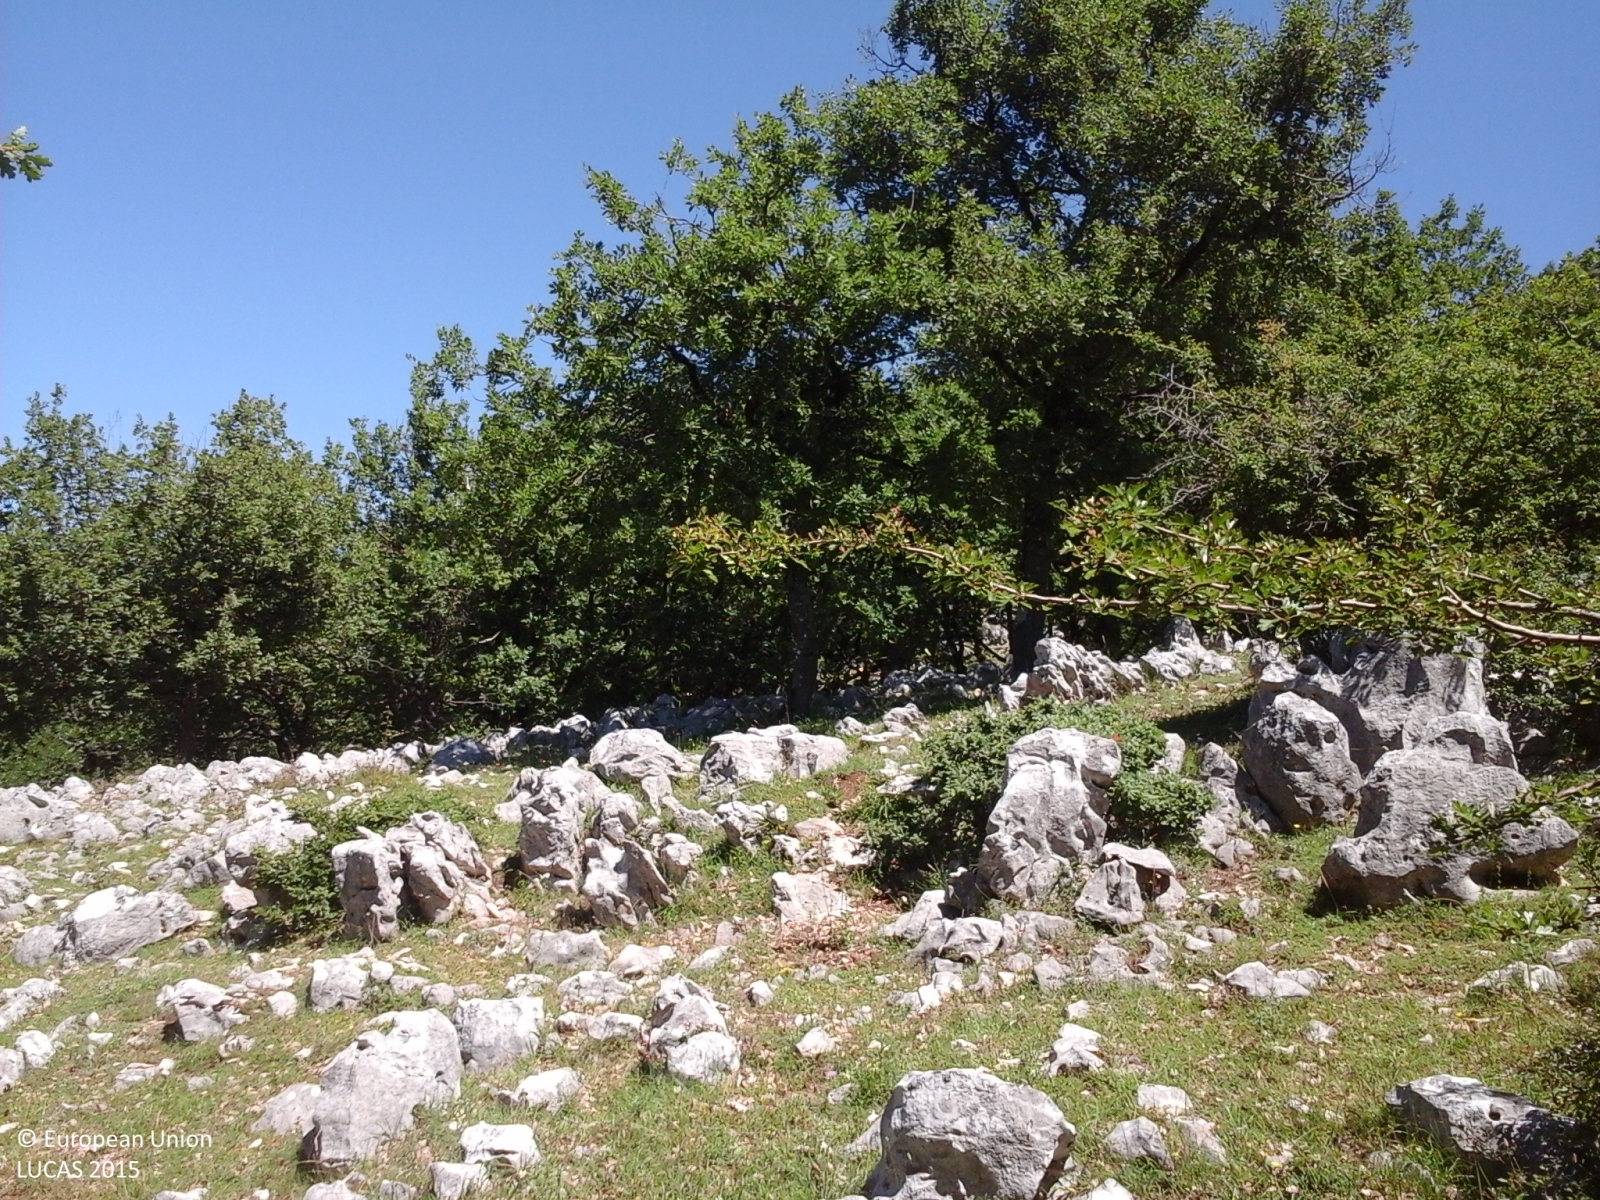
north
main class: Woodland
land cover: Broadleaved woodland
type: thermophilous deciduous forest
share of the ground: 50 - 75 %
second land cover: Grassland without tree/shrub cover
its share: > 75 %
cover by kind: herbaceous plants 50 %, broadleaved forest trees 40 %, shrubs 10 %
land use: Forestry
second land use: Agriculture (excluding fallow land and kitchen gardens)
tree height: > 5 m
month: June
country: IT
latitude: 41.6476
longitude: 13.1219
